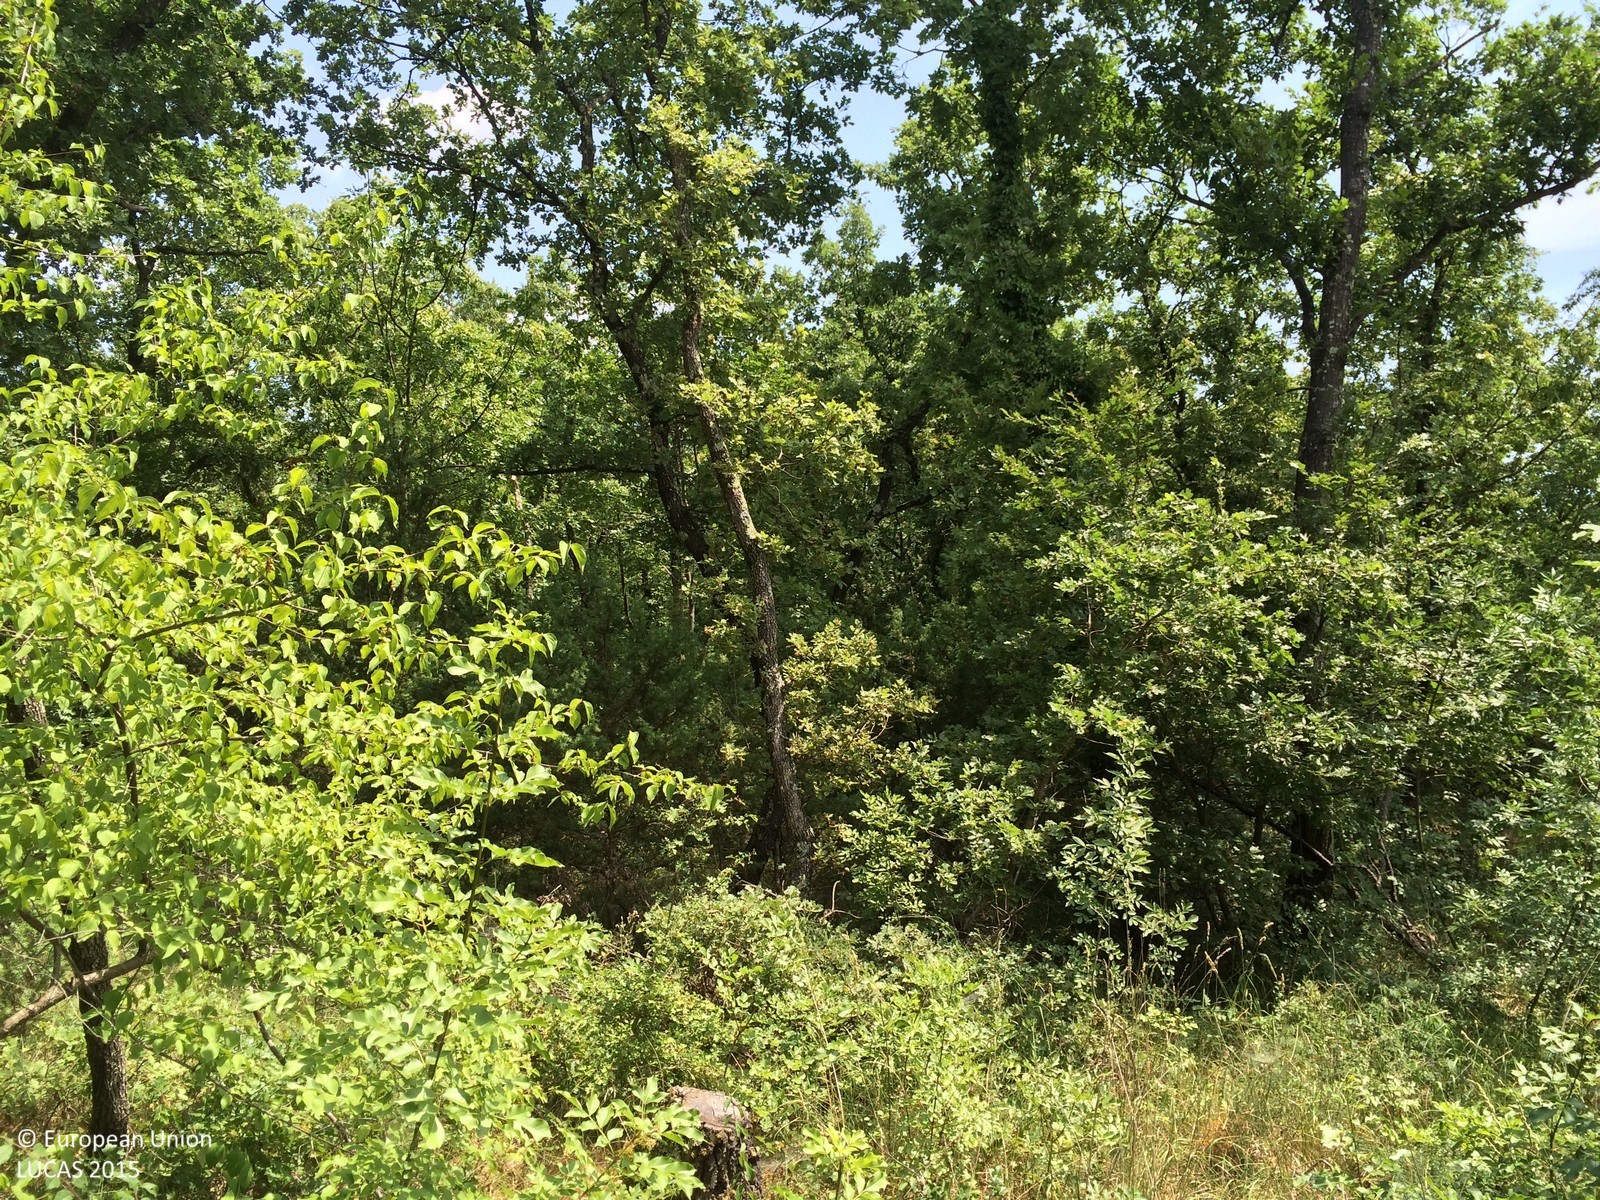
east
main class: Woodland
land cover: Broadleaved woodland
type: mesophytic deciduous forest
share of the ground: > 75 %
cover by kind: broadleaved forest trees 90 %, shrubs 5 %, herbaceous plants 5 %
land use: Semi-natural and natural areas not in use
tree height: > 5 m
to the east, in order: Broadleaved woodland; Tracks; Broadleaved woodland; Dry stone walls; Grassland without tree/shrub cover; Broadleaved woodland; Dry stone walls; Broadleaved woodland; Tracks; Broadleaved woodland
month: June
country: HR
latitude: 45.0727
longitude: 13.8686
